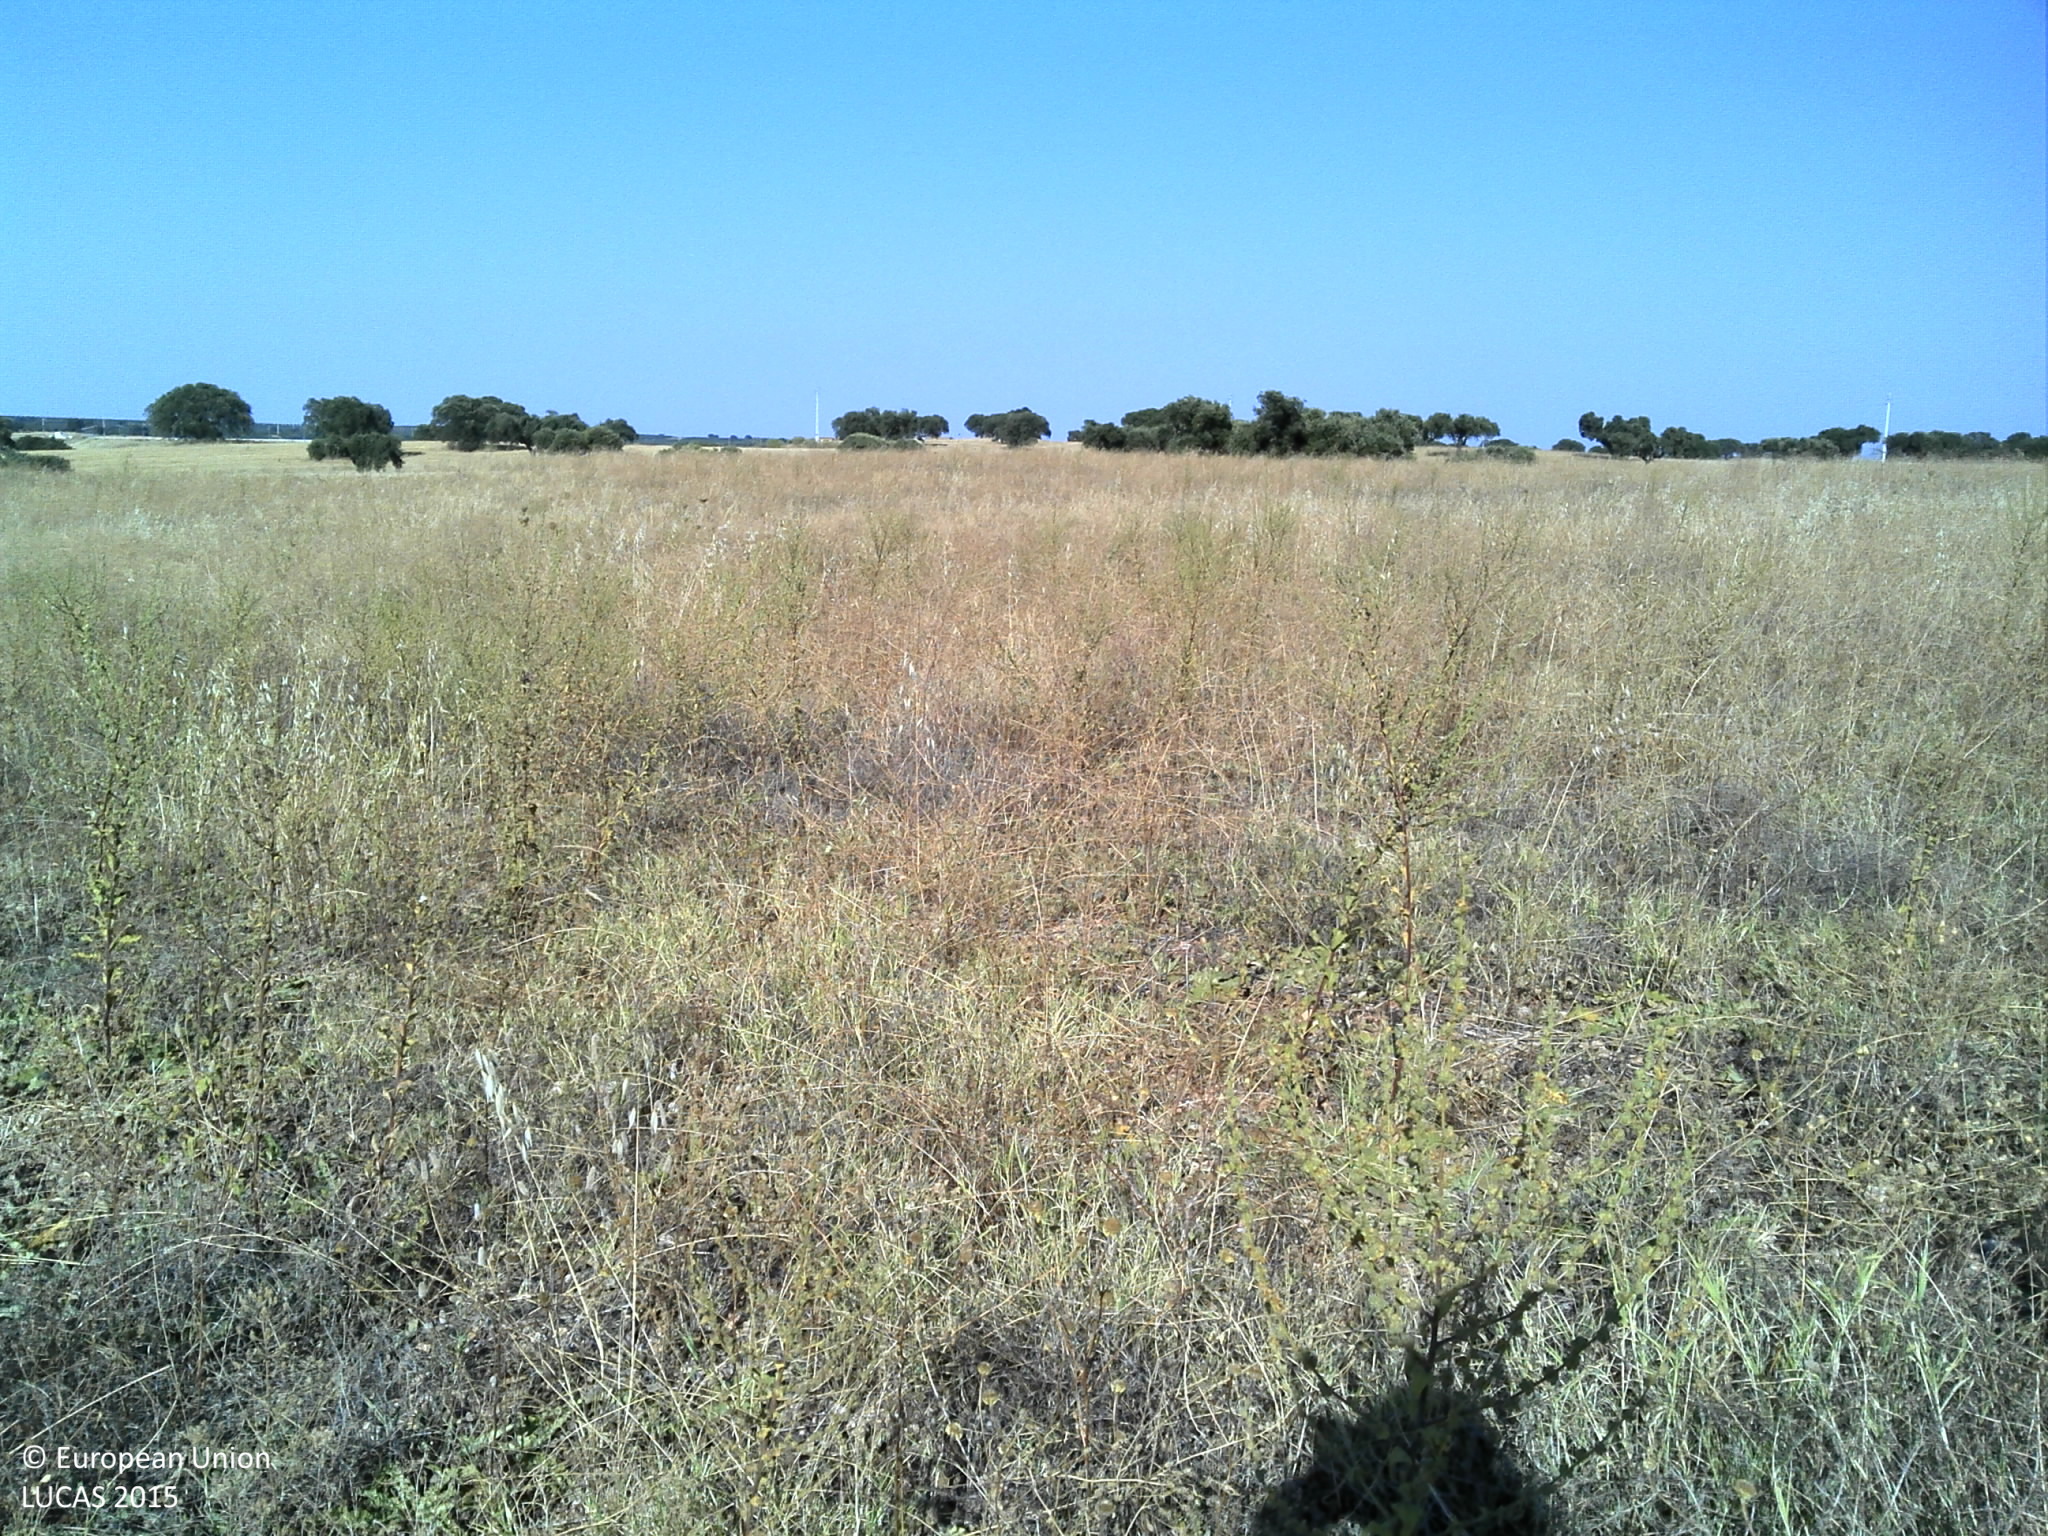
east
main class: Grassland
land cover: Spontaneously vegetated surfaces
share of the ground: > 75 %
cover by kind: herbaceous plants 80 %, unconsolidated bare surface 20 %
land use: Agriculture (excluding fallow land and kitchen gardens)
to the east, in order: Spontaneously vegetated surfaces; Grassland with sparse tree/shrub cover
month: June
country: PT
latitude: 38.0947
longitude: -7.5712
